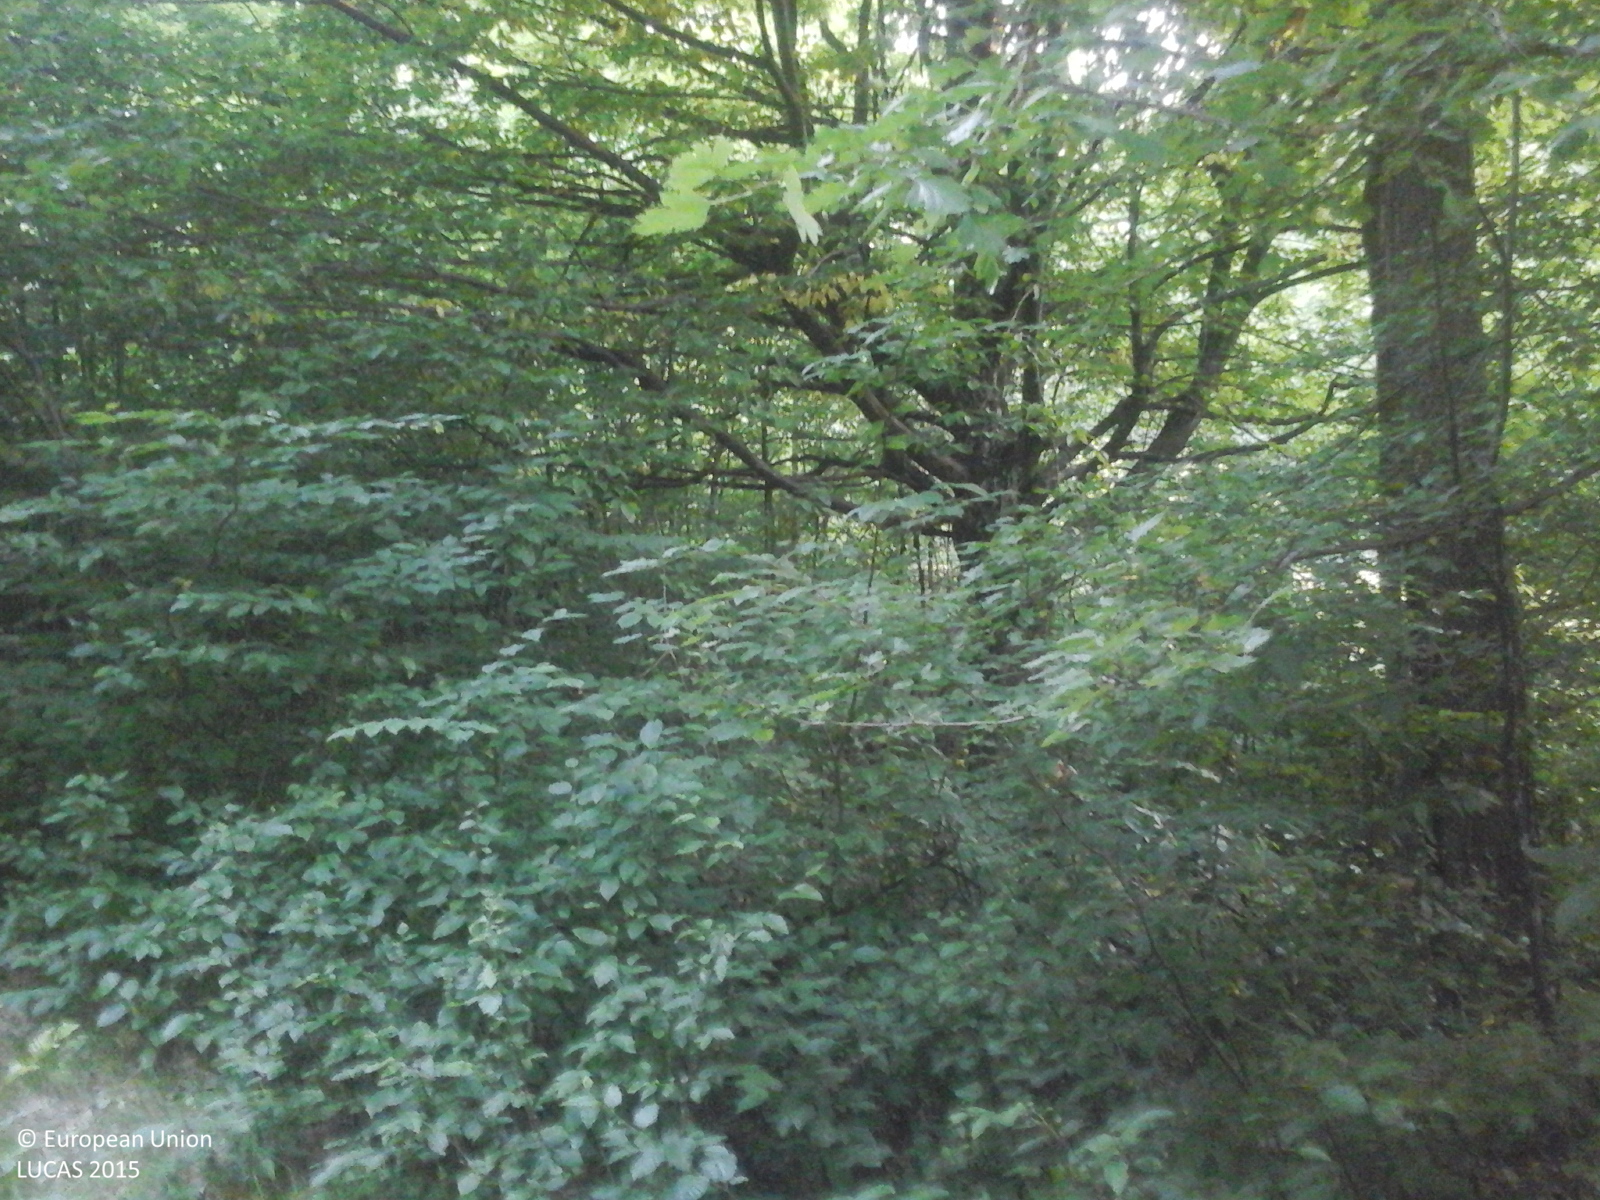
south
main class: Woodland
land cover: Broadleaved woodland
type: beech forest
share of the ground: > 75 %
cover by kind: broadleaved forest trees 100 %
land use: Forestry
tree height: > 5 m
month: July
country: RO
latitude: 44.9632
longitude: 24.5671
